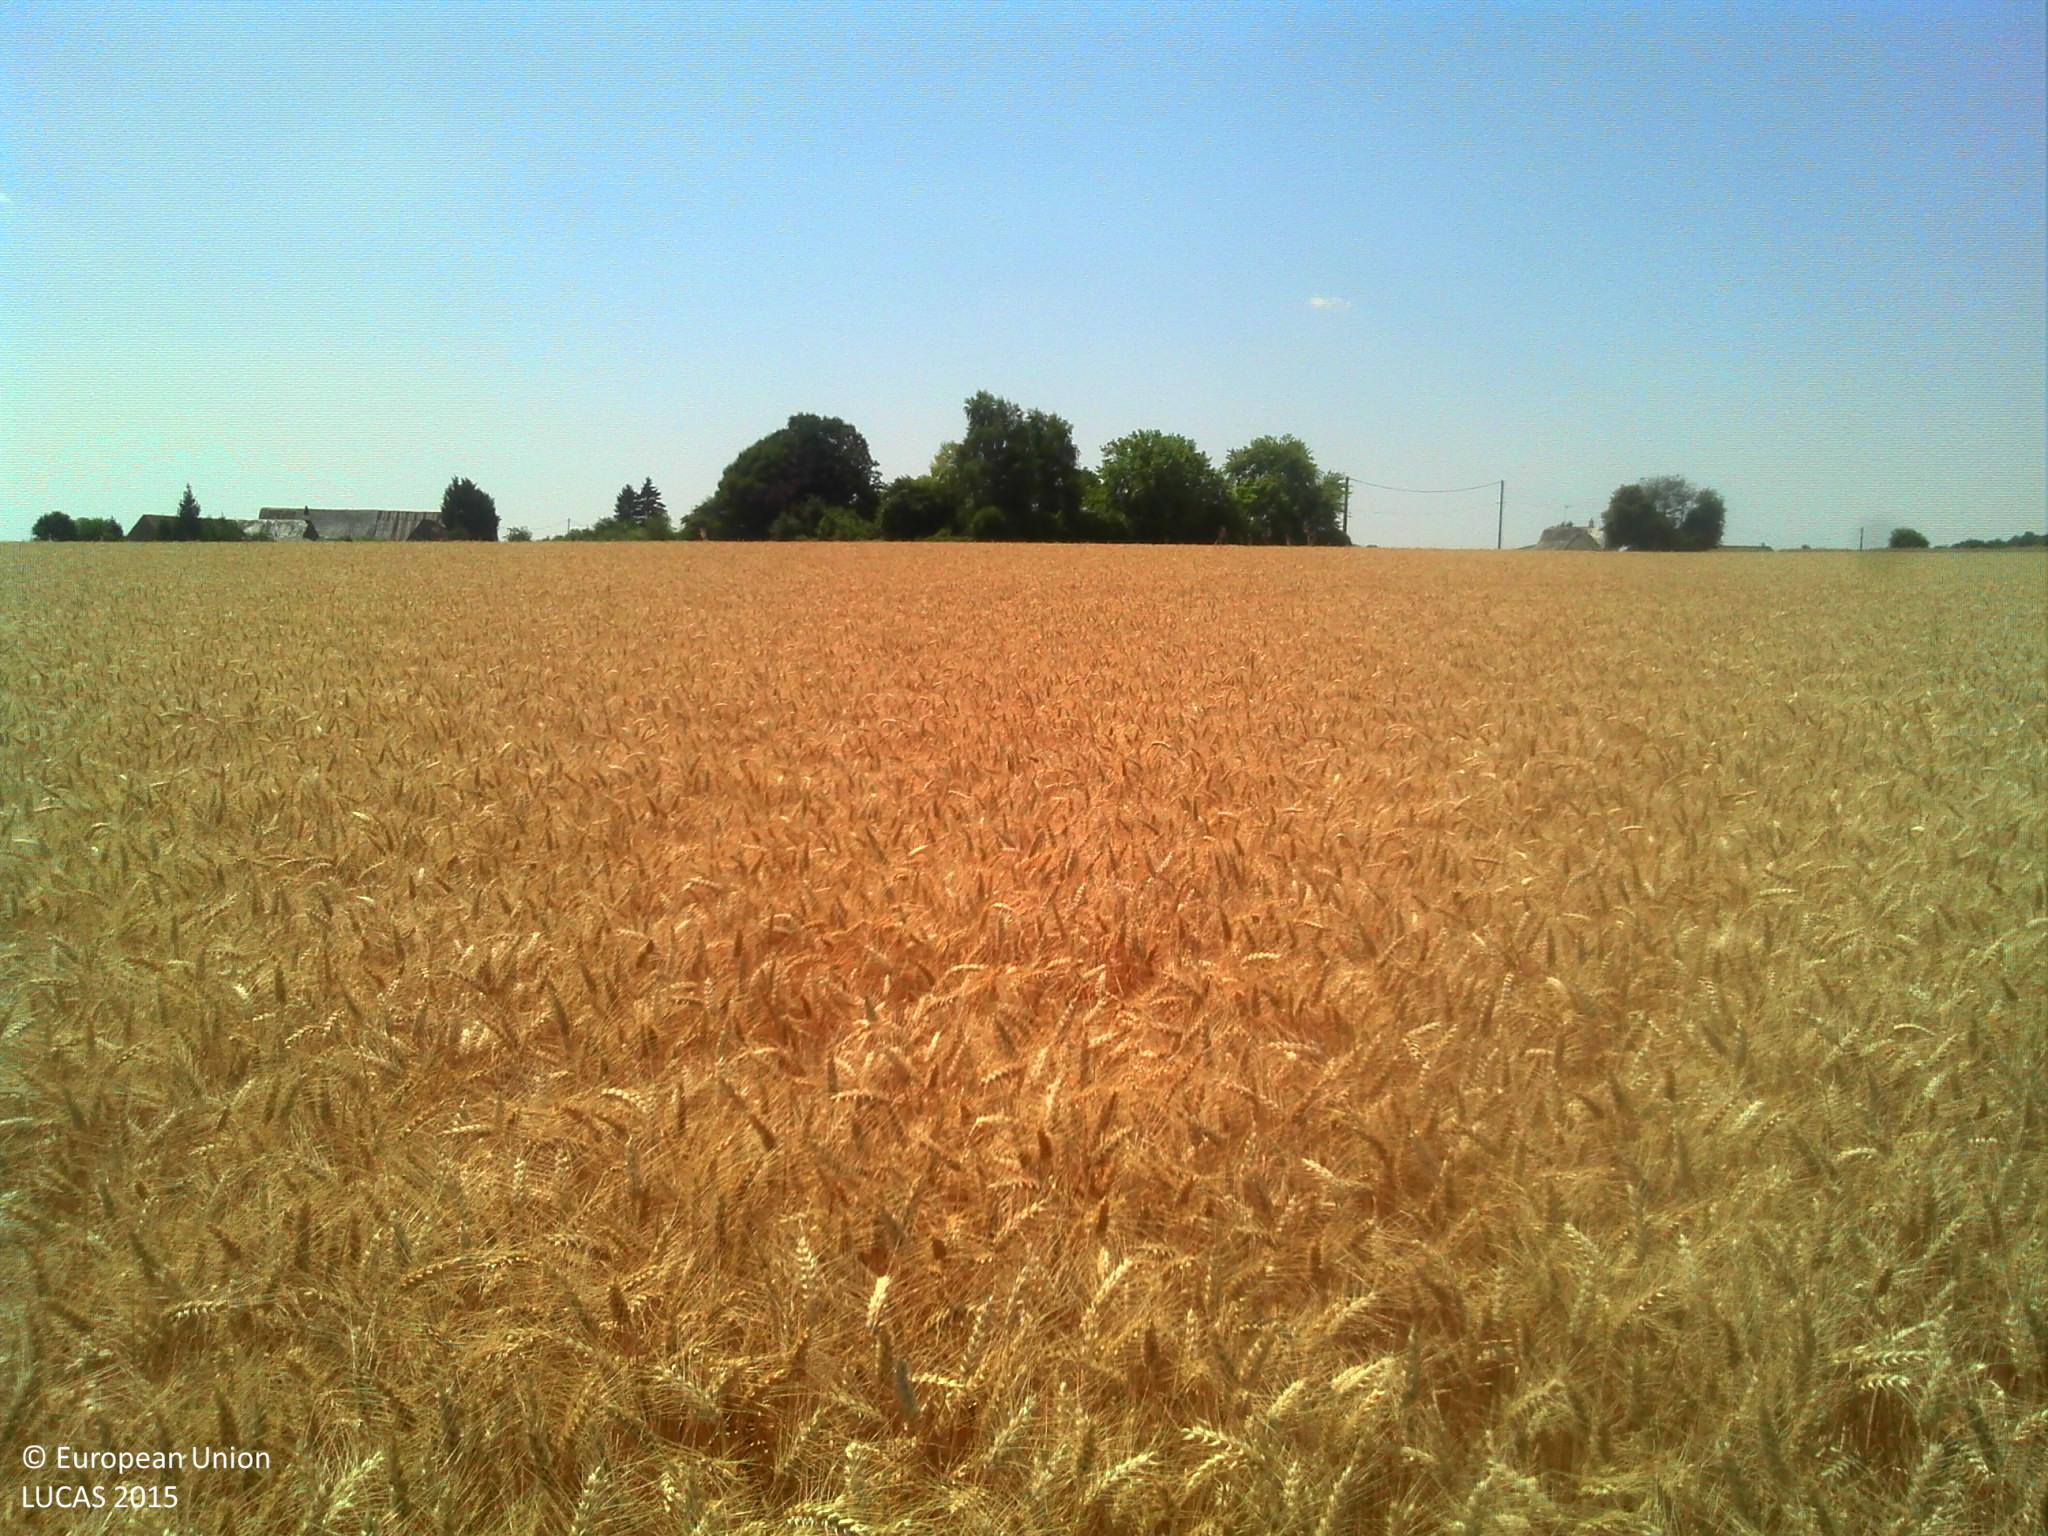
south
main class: Cropland
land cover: Common wheat
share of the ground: > 75 %
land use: Agriculture (excluding fallow land and kitchen gardens)
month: July
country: FR
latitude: 48.1494
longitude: 1.2860
